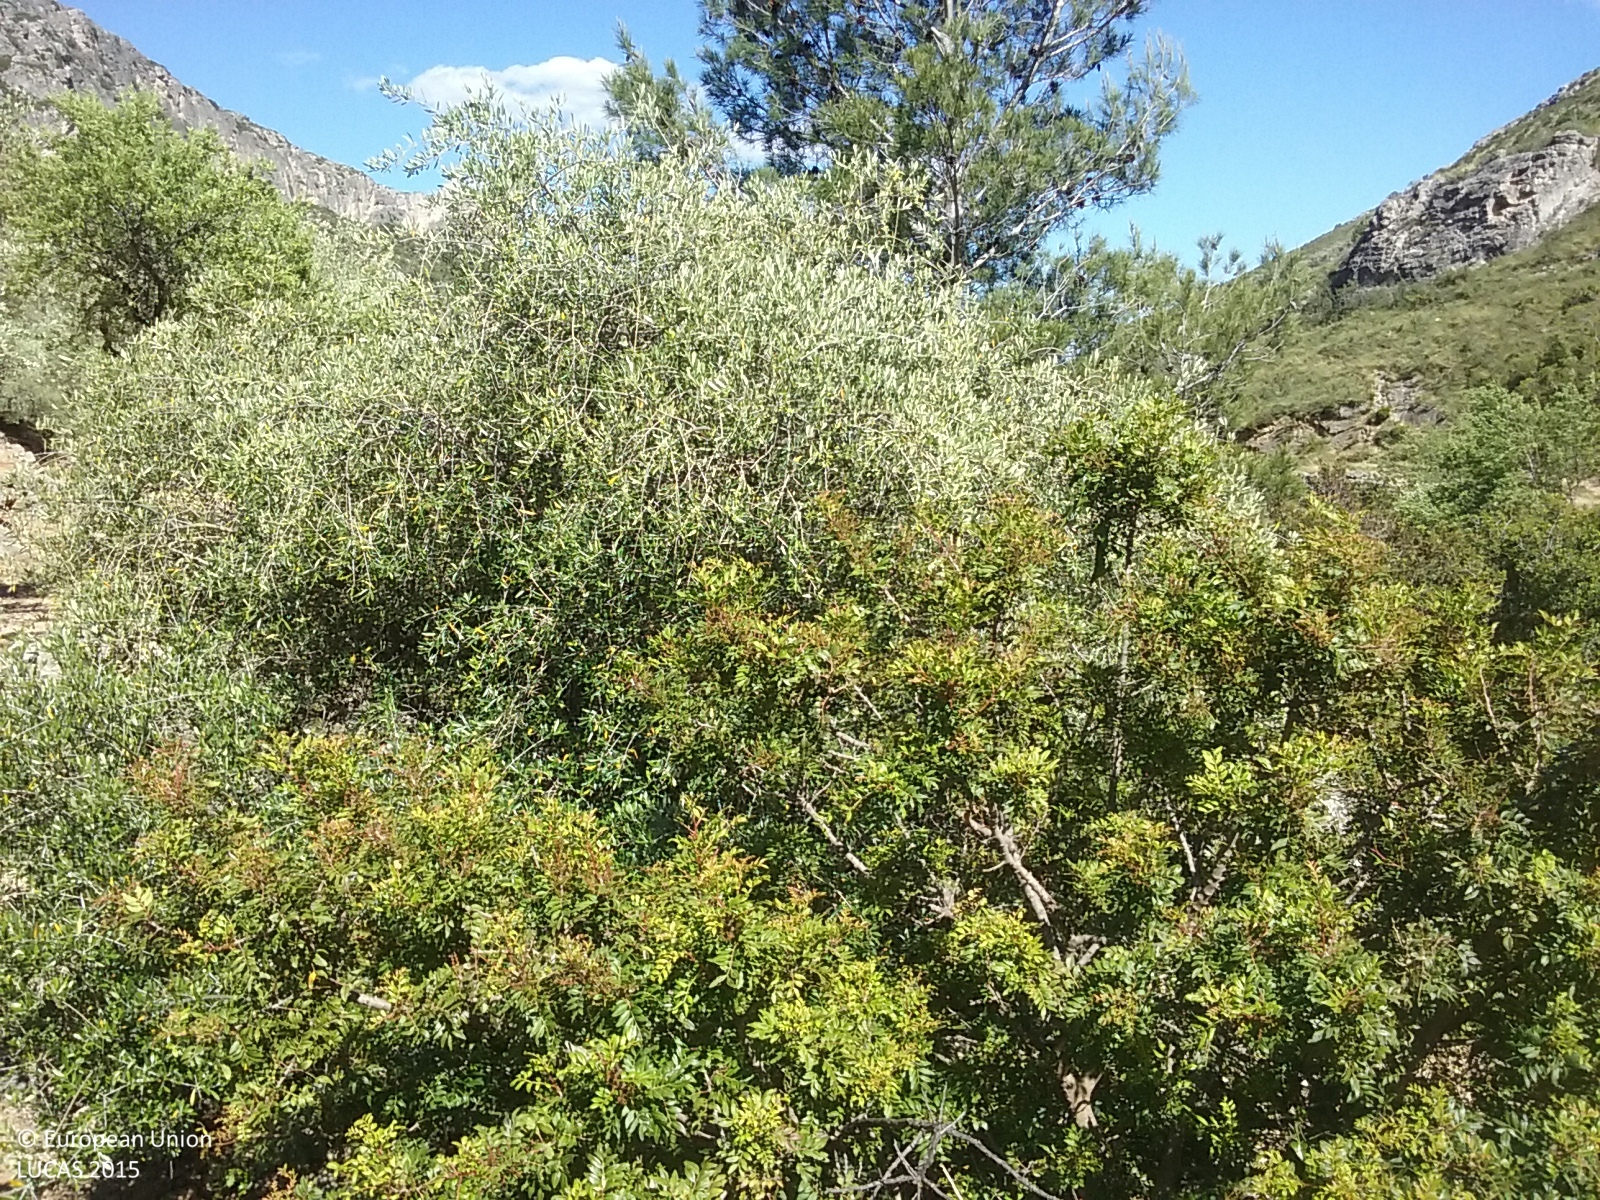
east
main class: Cropland
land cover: Olive groves
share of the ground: 25 - 50 %
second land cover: Other bare soil
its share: > 75 %
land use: Agriculture (excluding fallow land and kitchen gardens)
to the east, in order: Olive groves; Other bare soil; Dry stone walls; Olive groves; Dry stone walls; Olive groves; Dry stone walls; Olive groves; Dry stone walls; Olive groves; Dry stone walls; Olive groves; Dry stone walls; Shrubland with sparse tree cover; Dry stone walls; Shrubland with sparse tree cover; Dry stone walls; Shrubland with sparse tree cover; Dry stone walls; Shrubland with sparse tree cover
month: May
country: ES
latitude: 40.7770
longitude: 0.3843
